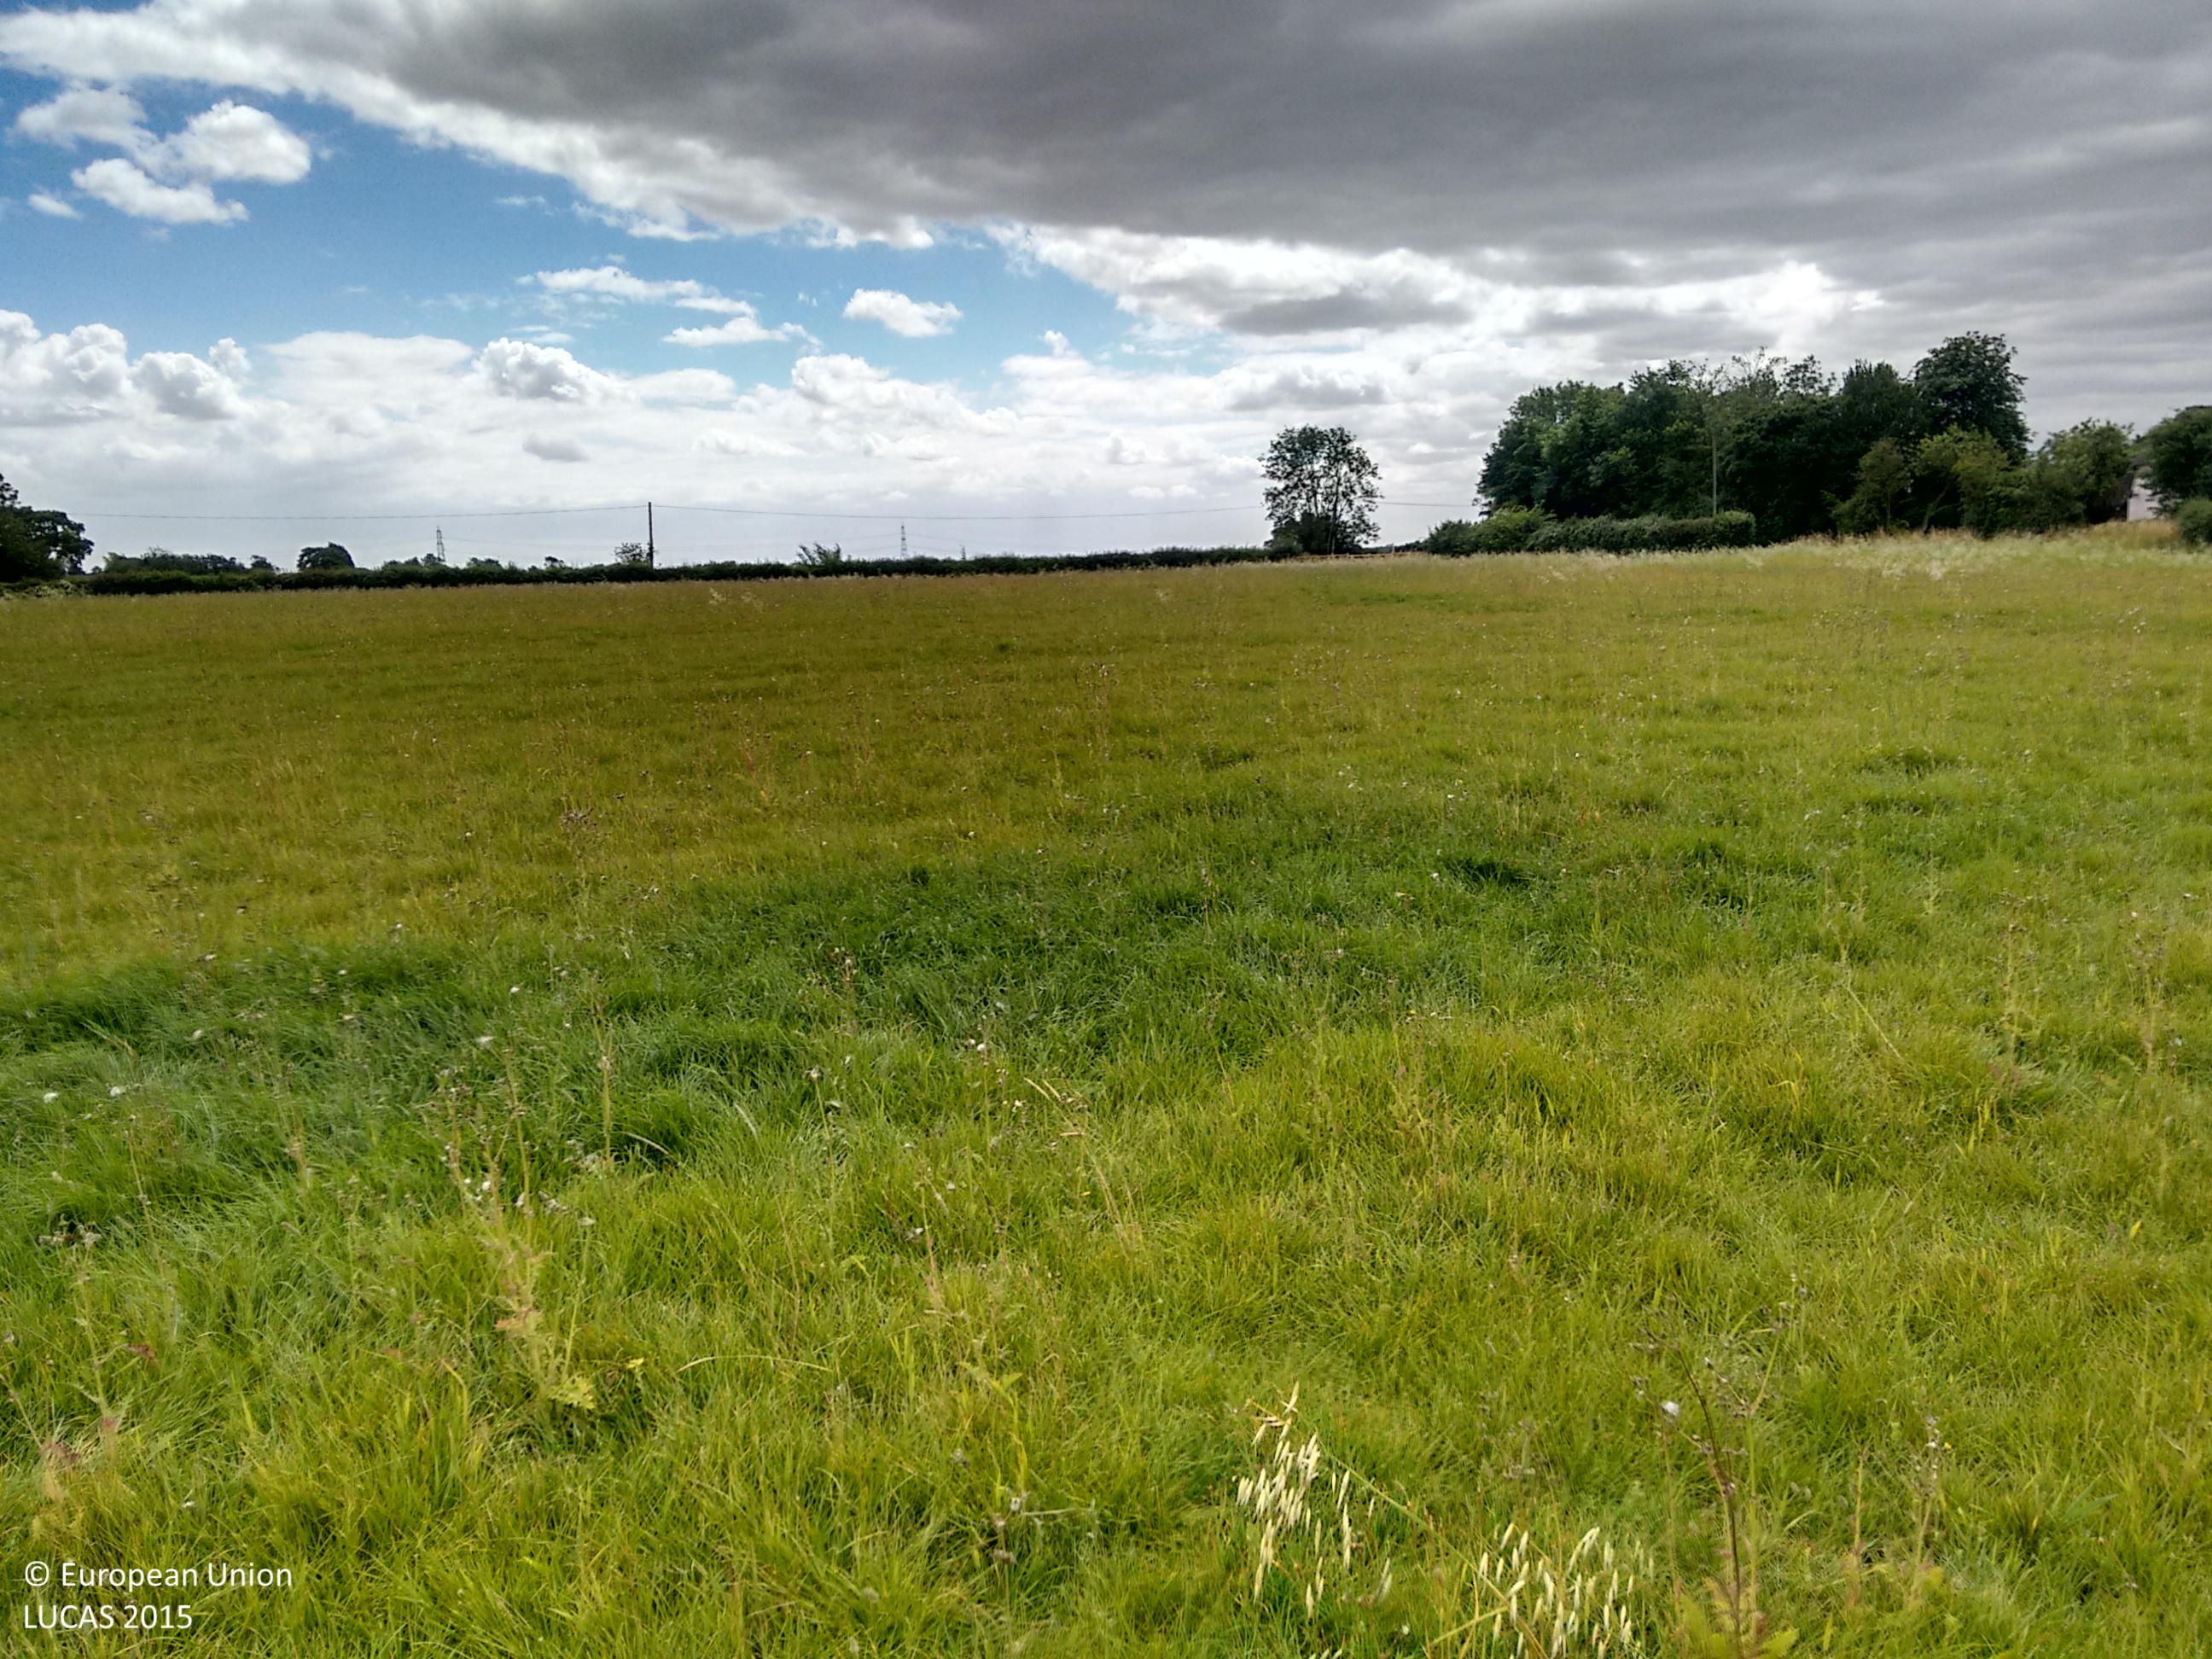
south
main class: Grassland
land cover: Grassland without tree/shrub cover
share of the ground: > 75 %
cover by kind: herbaceous plants 100 %
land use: Agriculture (excluding fallow land and kitchen gardens)
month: August
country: GB
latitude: 52.0057
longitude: 0.4003
